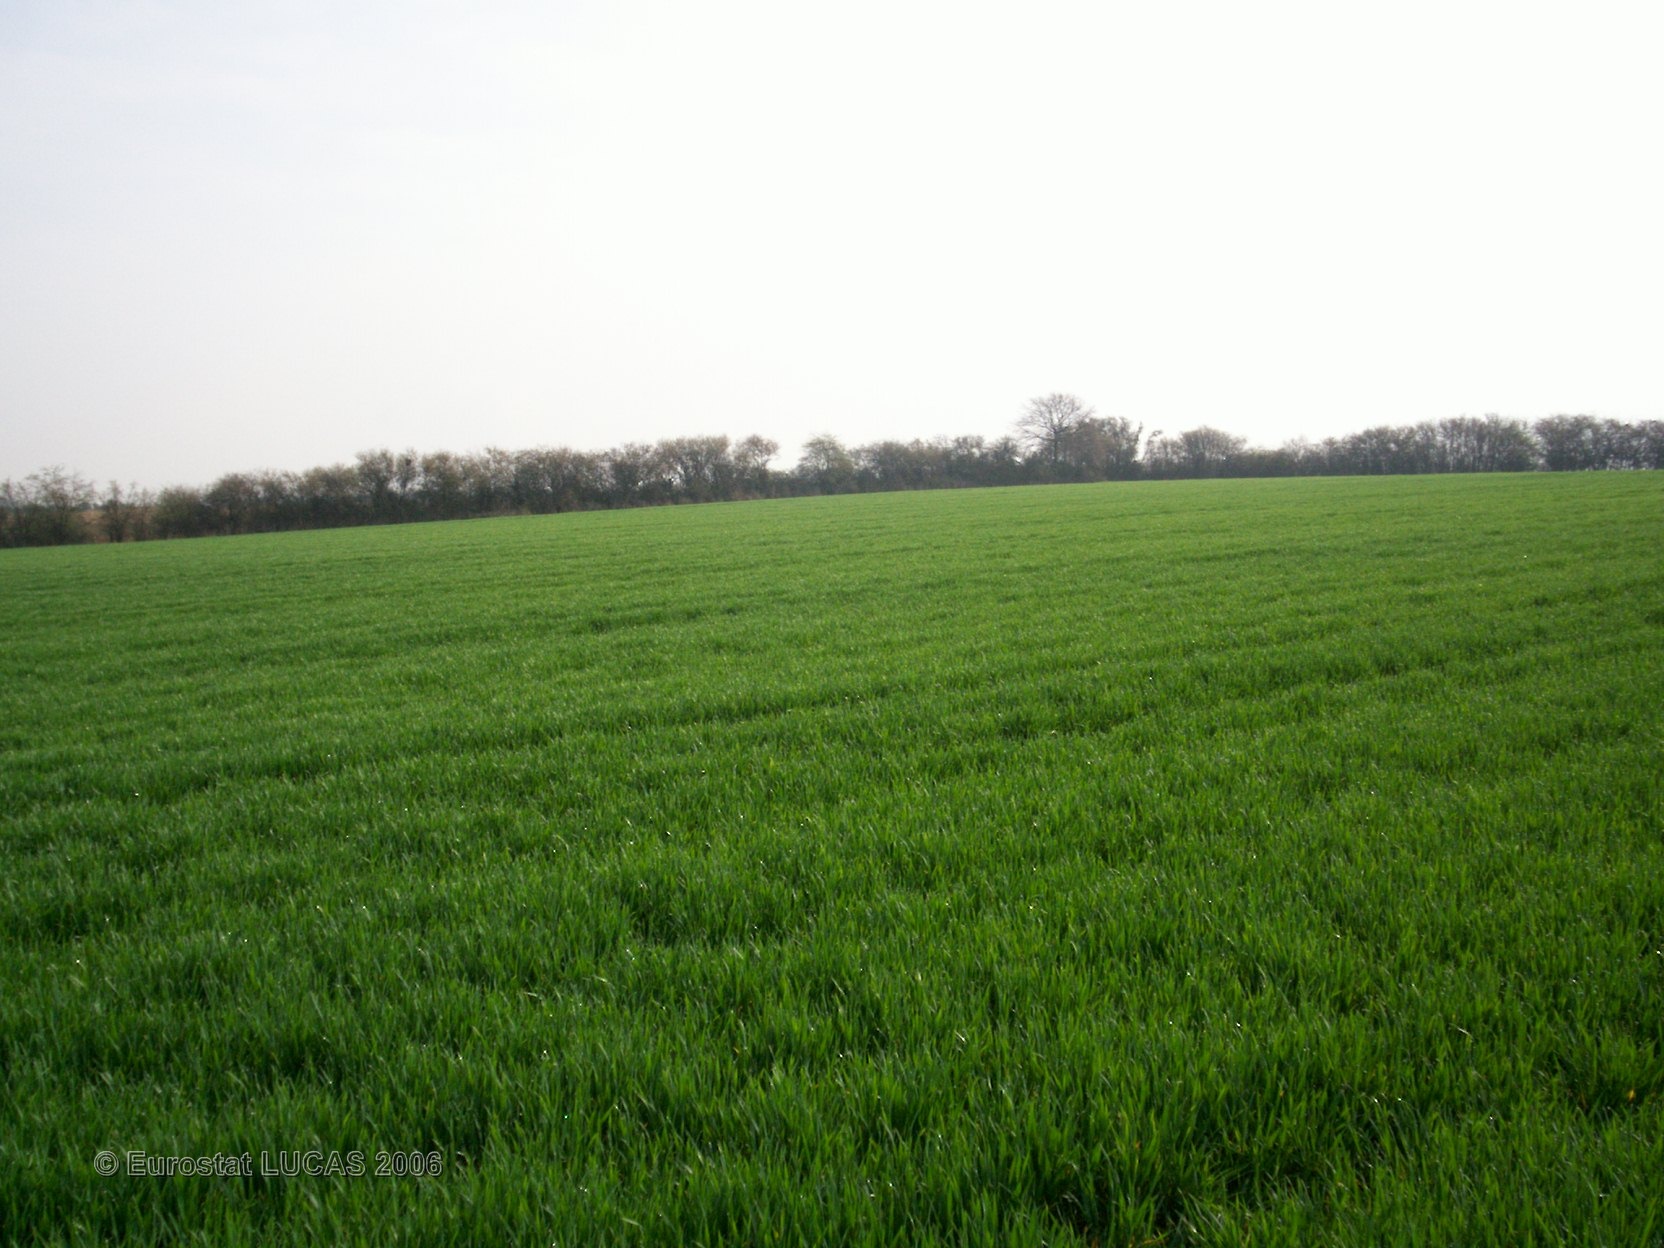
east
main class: Cropland
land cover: Common wheat
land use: Agriculture (excluding fallow land and kitchen gardens)
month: April
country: FR
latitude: 48.7062
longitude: 5.9094
